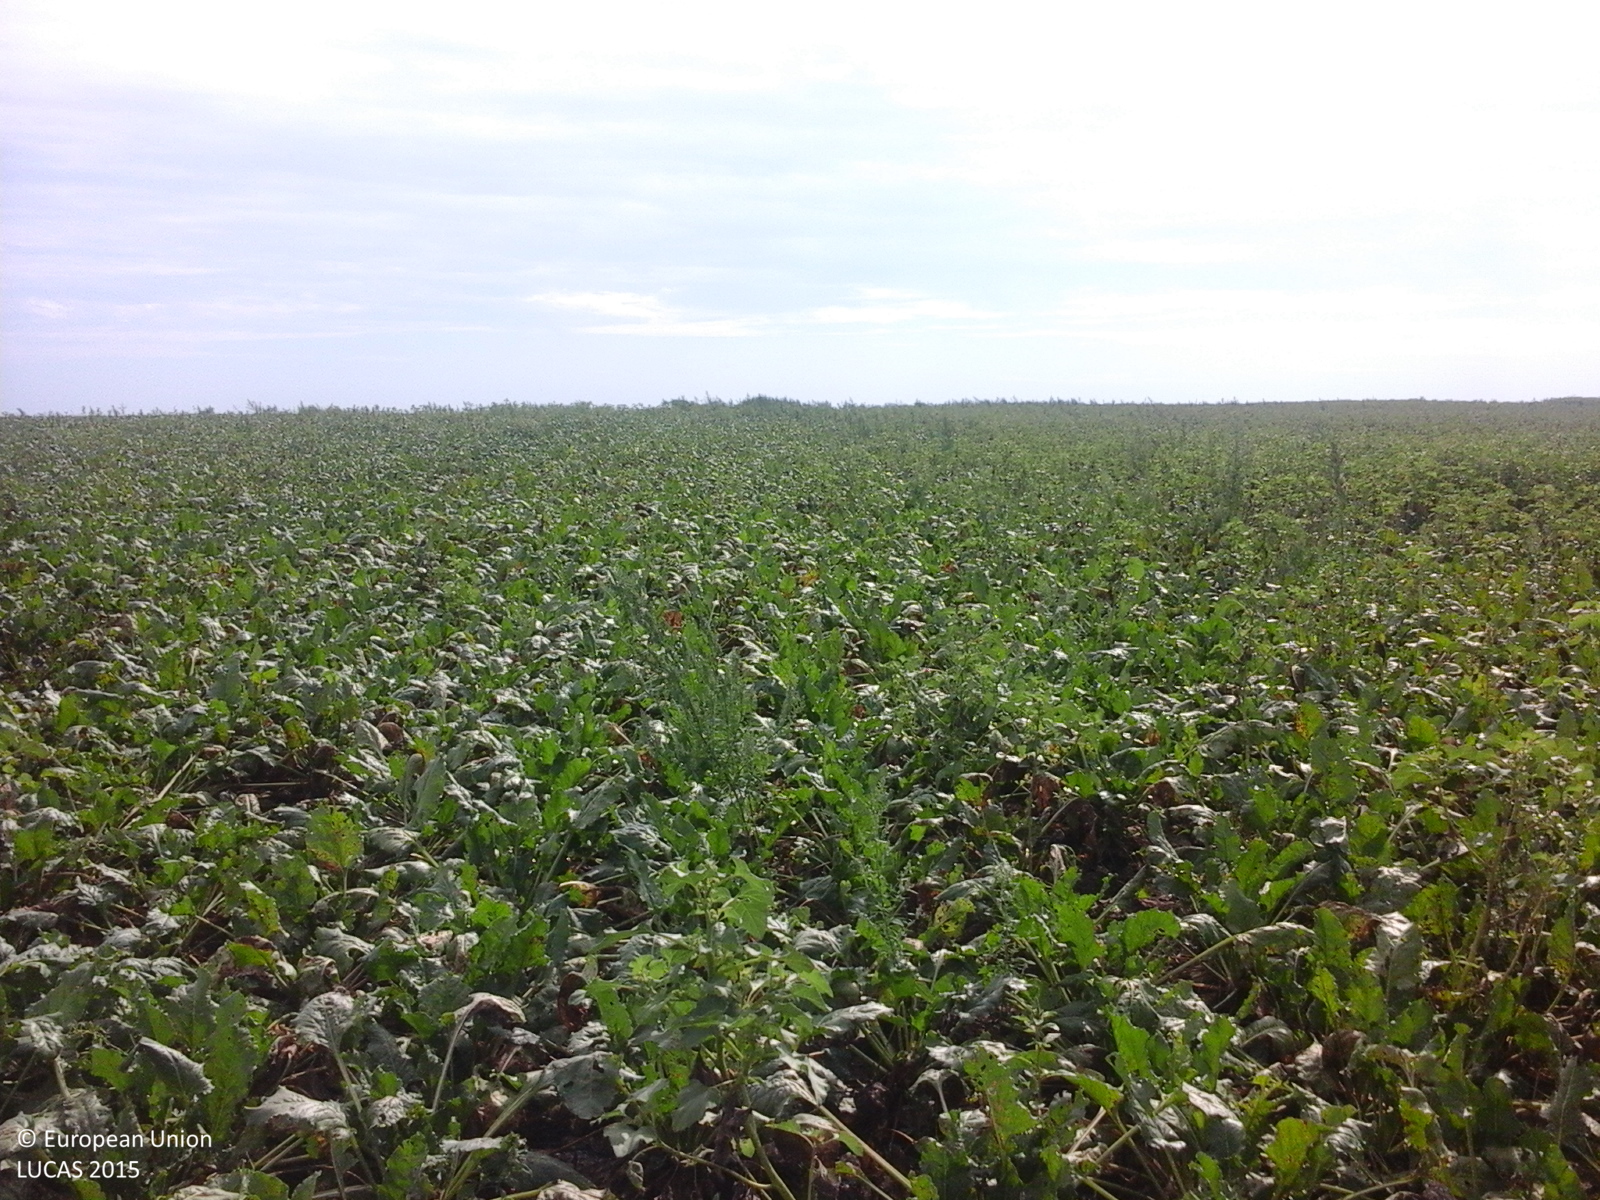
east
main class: Cropland
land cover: Sugar beet
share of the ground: > 75 %
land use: Agriculture (excluding fallow land and kitchen gardens)
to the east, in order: Sugar beet
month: August
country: RO
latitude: 46.1769
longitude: 20.8712
